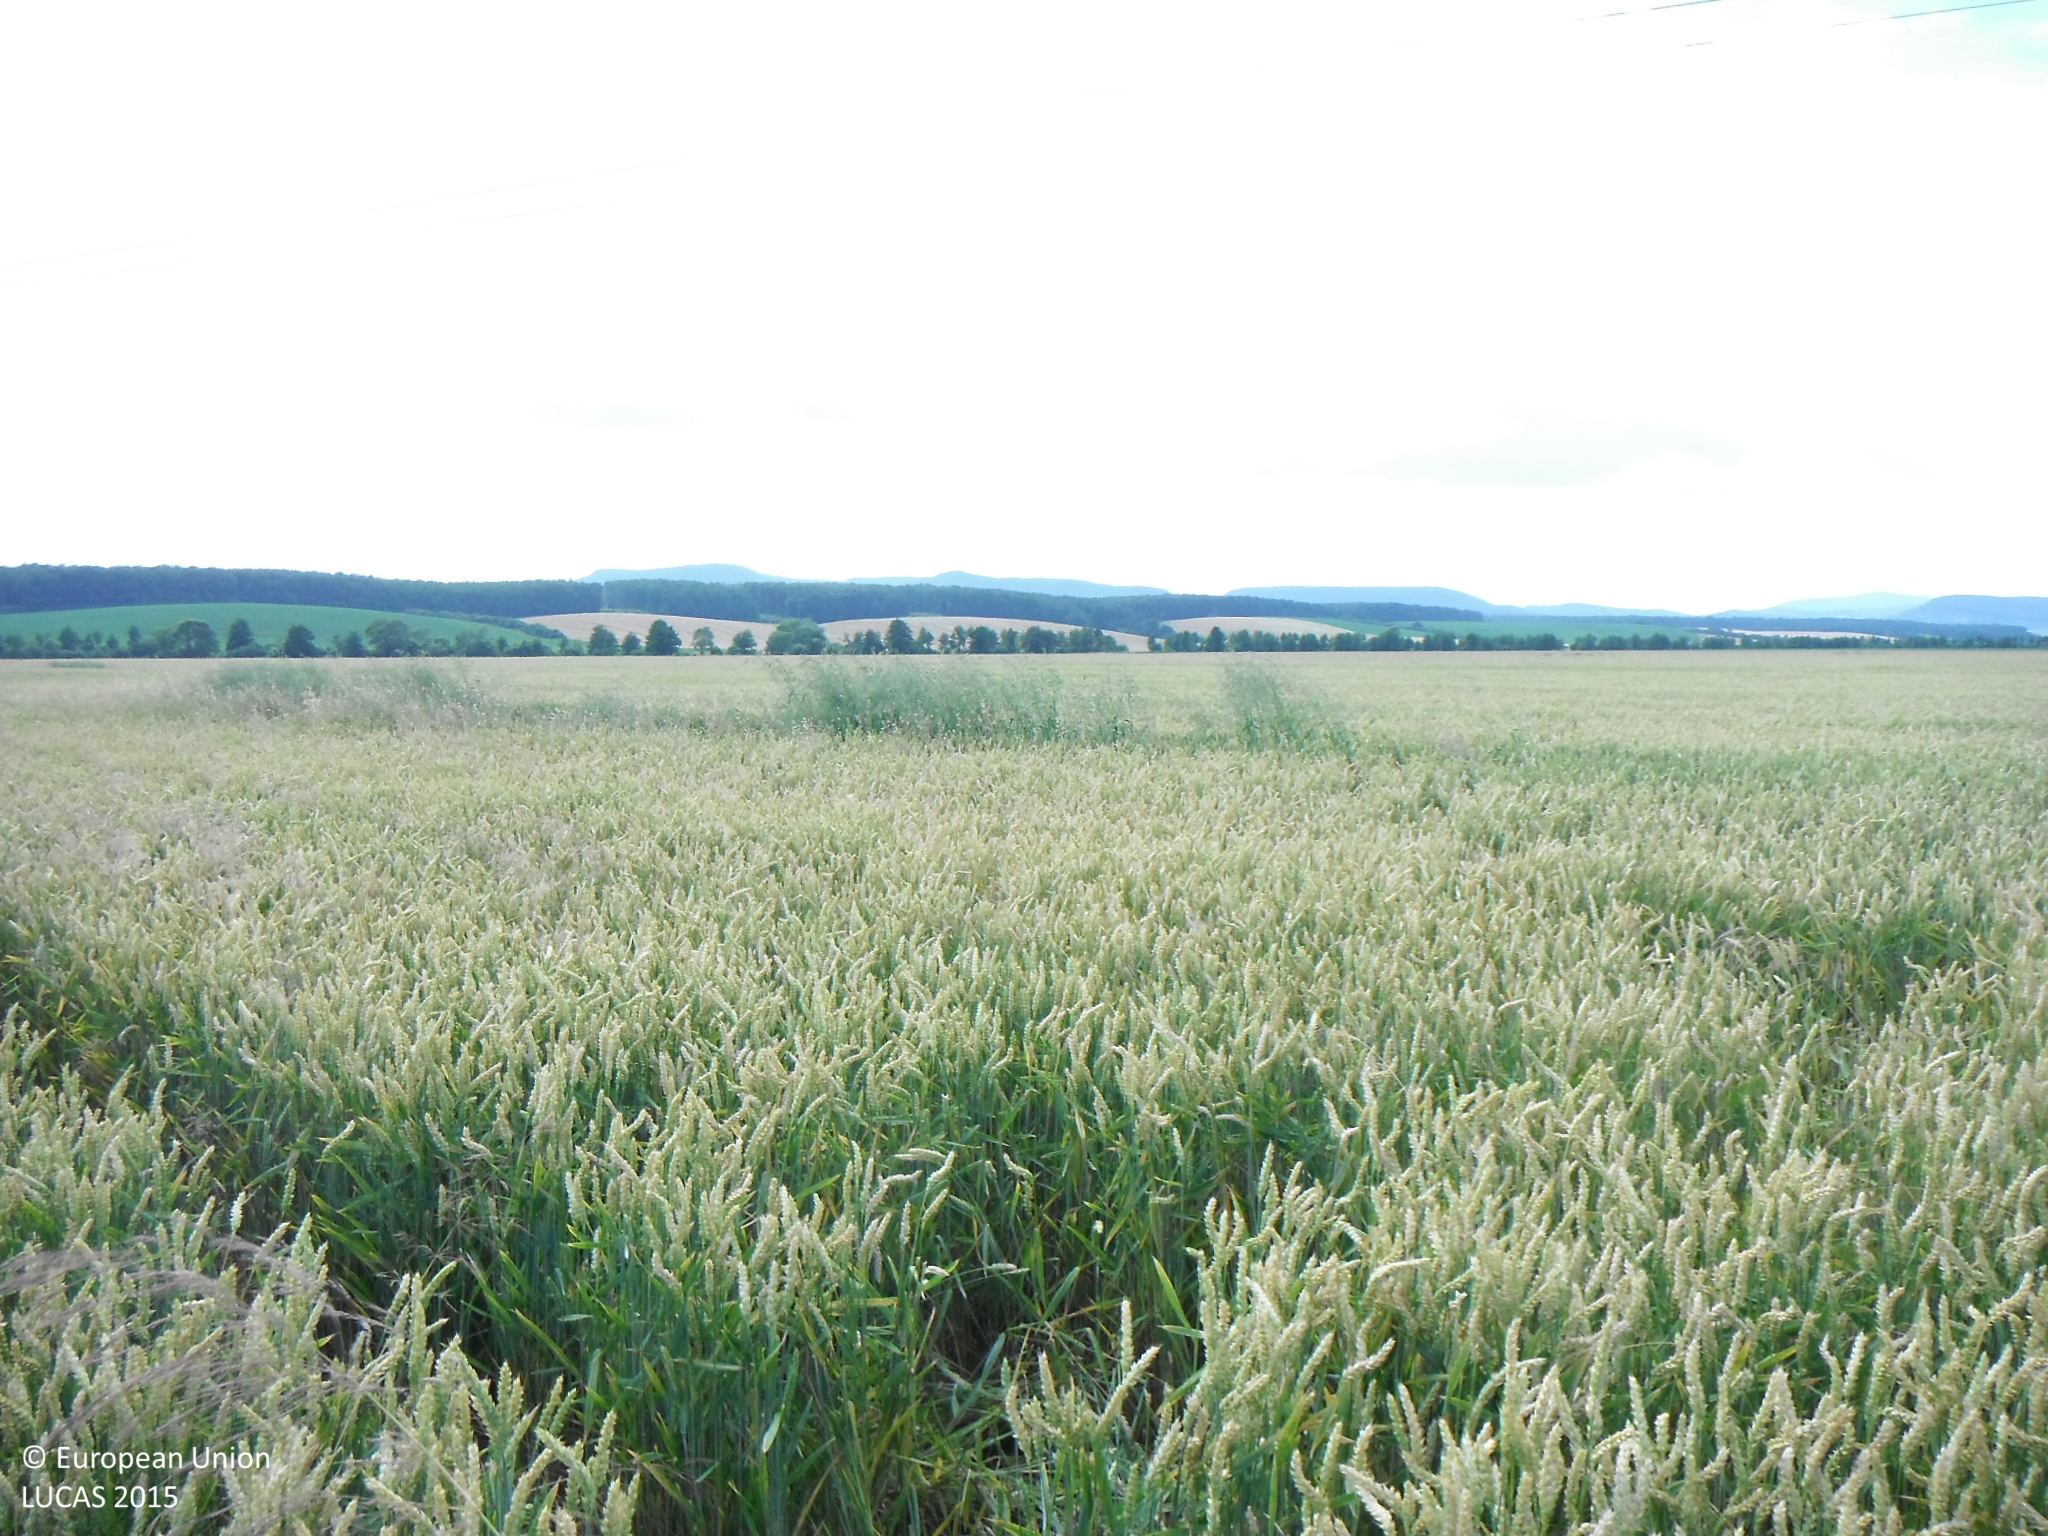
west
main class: Cropland
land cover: Common wheat
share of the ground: > 75 %
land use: Agriculture (excluding fallow land and kitchen gardens)
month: June
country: SK
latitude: 48.4270
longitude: 20.1258
